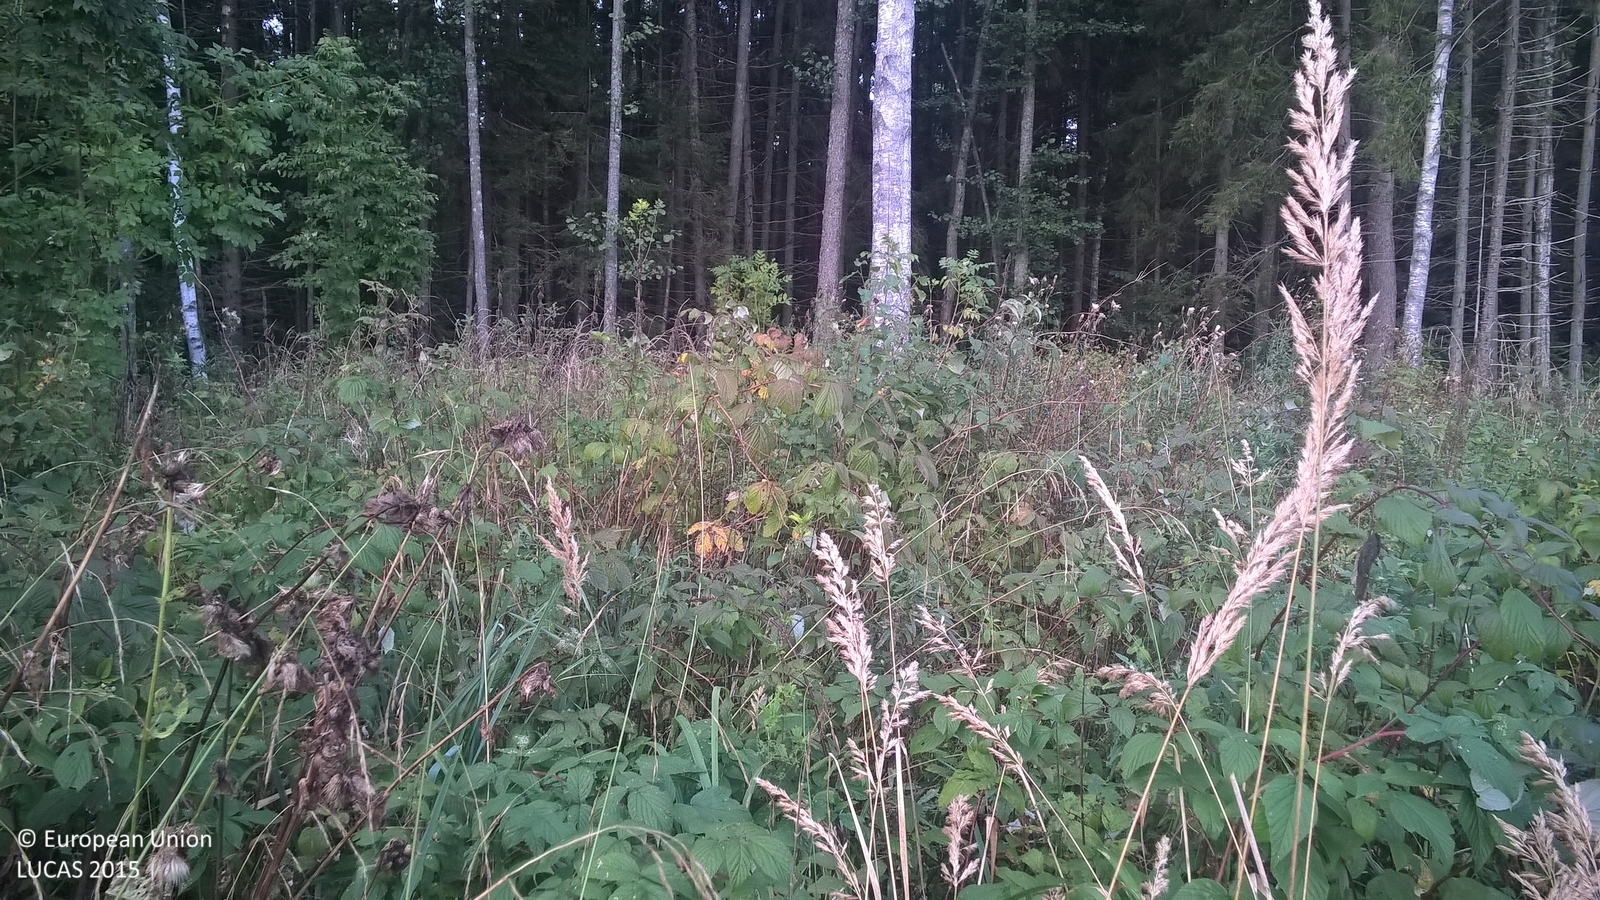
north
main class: Shrubland
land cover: Shrubland with sparse tree cover
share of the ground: > 75 %
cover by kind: shrubs 95 %, broadleaved forest trees 5 %
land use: Forestry
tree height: < 5 m
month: September
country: LV
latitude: 57.8396
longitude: 25.6989
